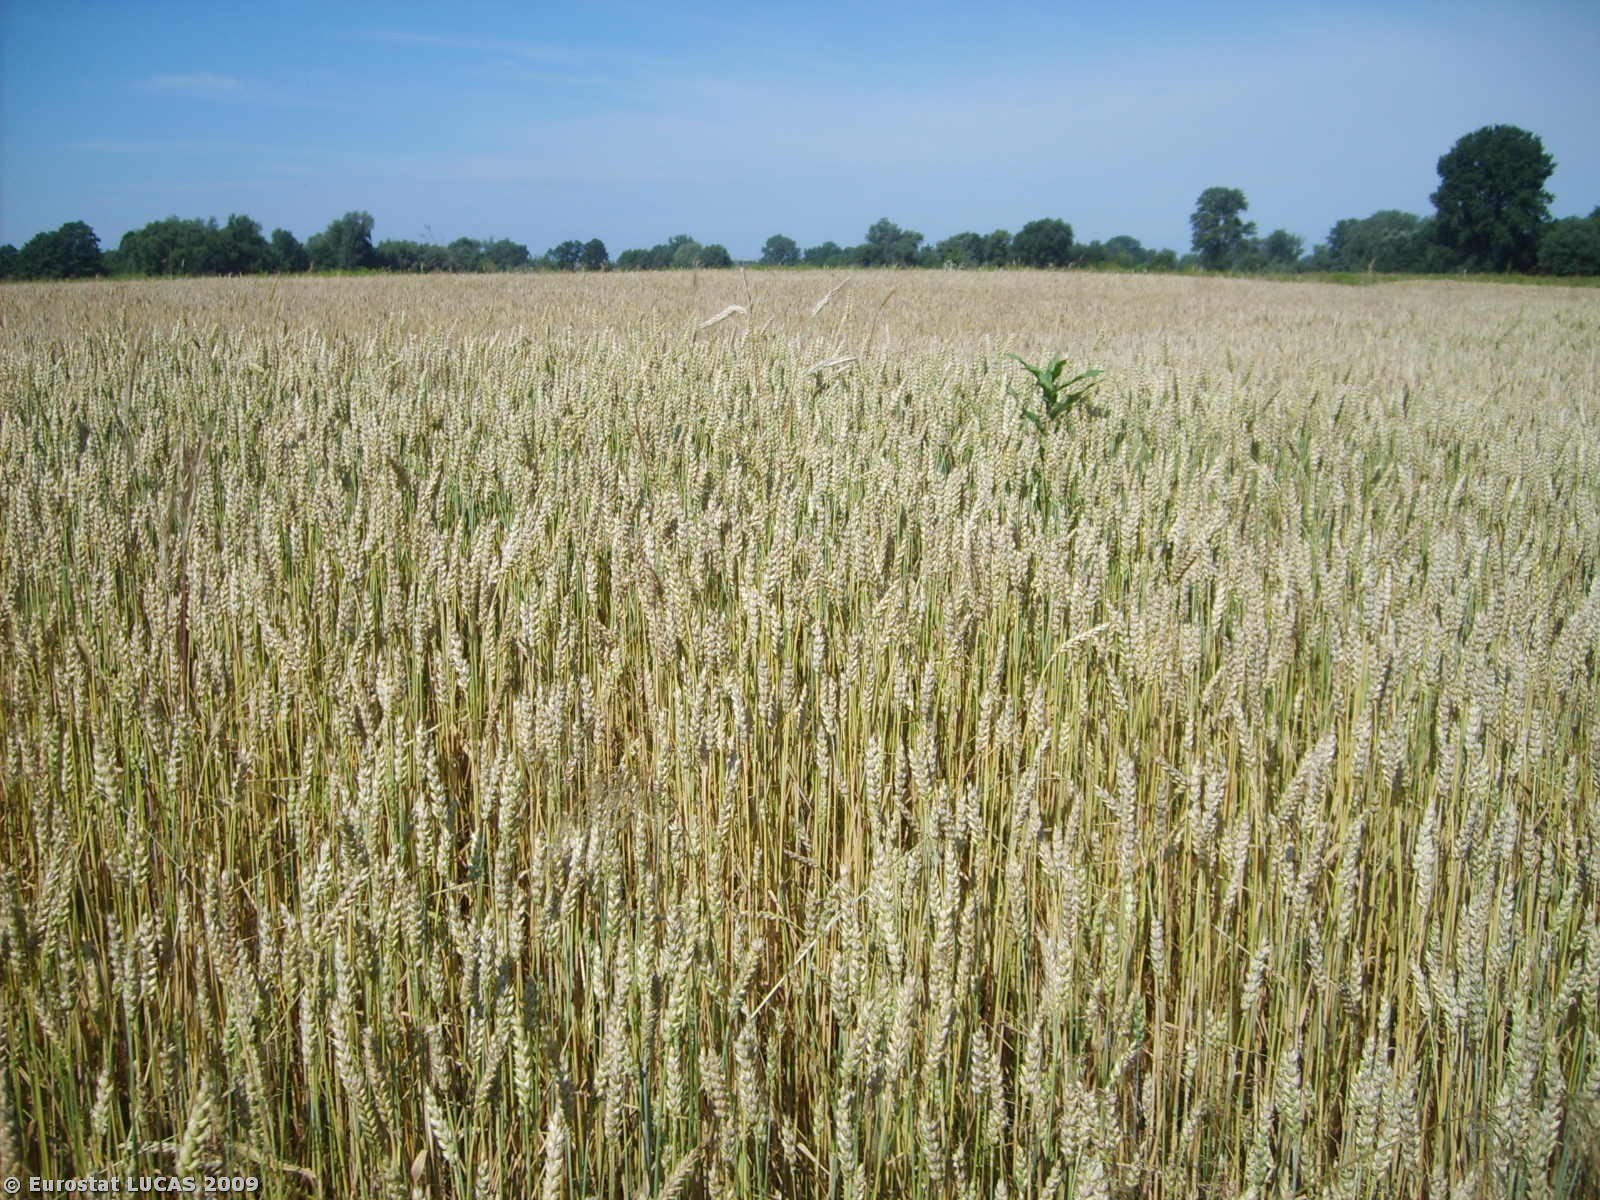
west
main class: Cropland
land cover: Common wheat
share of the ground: > 75 %
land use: Agriculture (excluding fallow land and kitchen gardens)
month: July
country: PL
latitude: 52.3954
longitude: 20.7545
